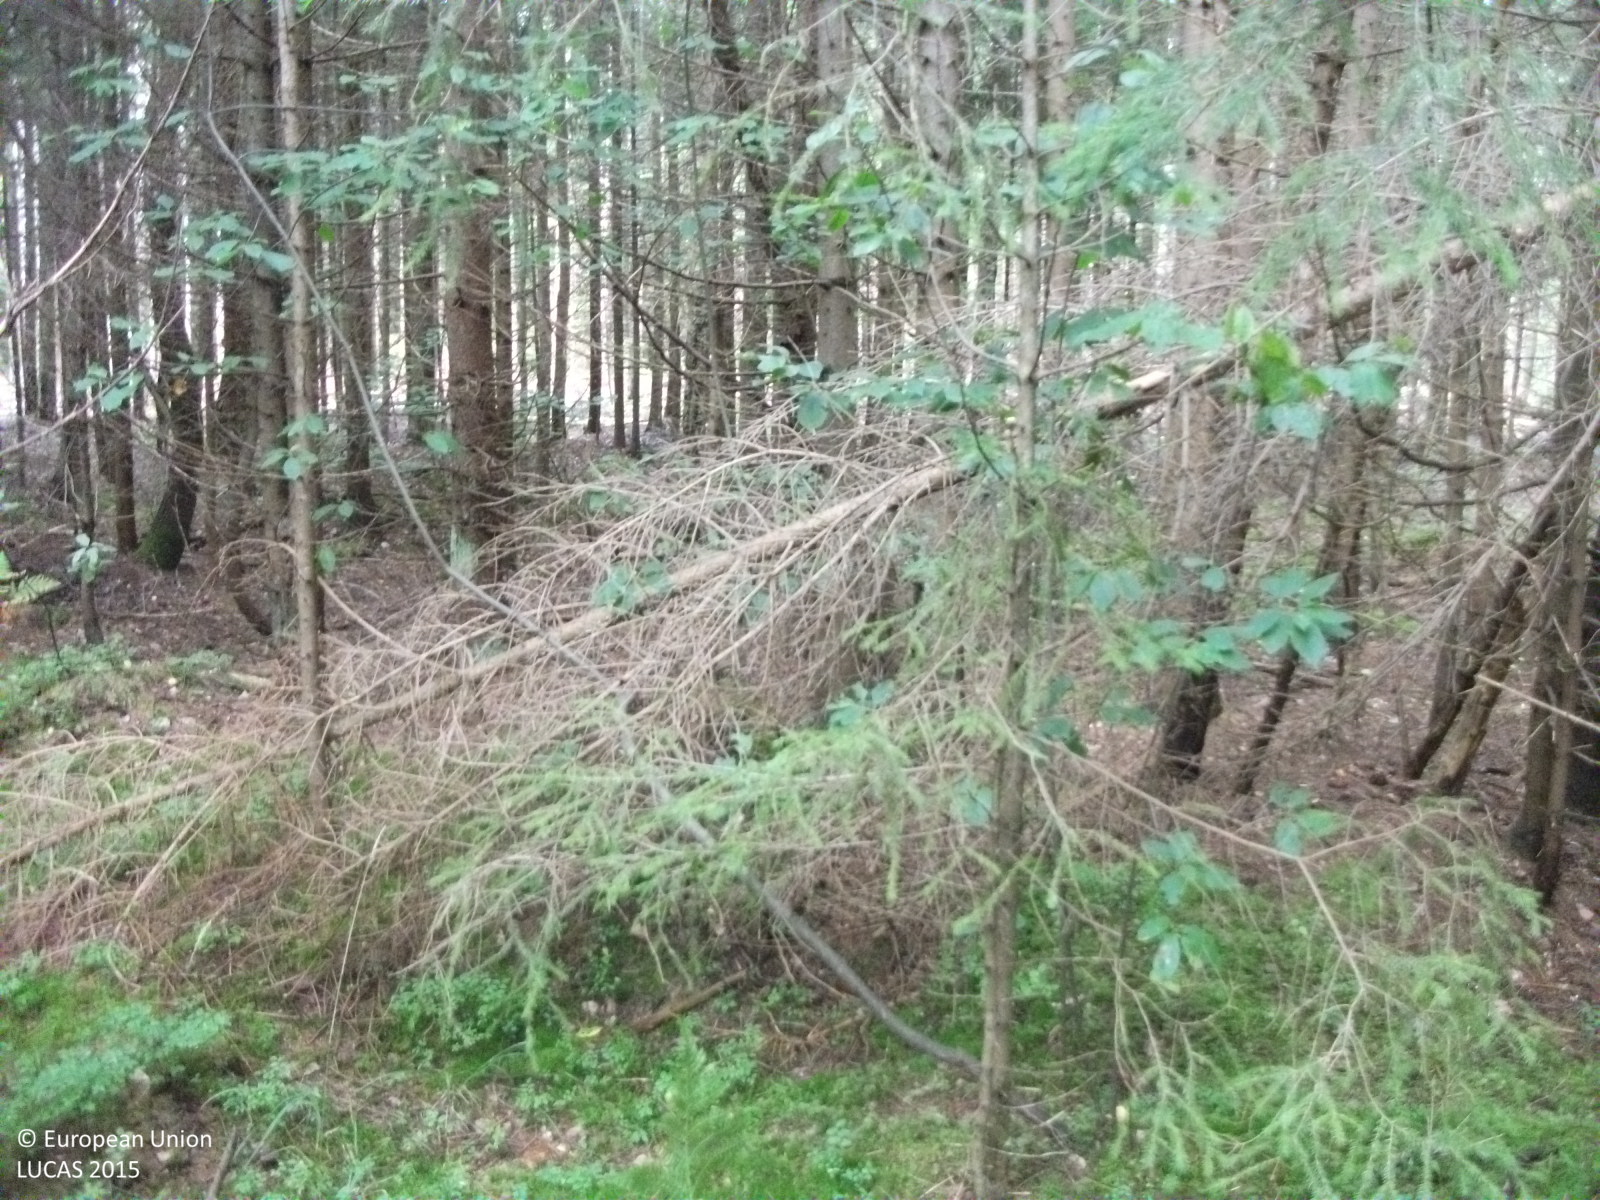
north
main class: Woodland
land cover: Spruce dominated coniferous woodland
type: hemiboreal forest and nemoral coniferous forest and mixed broadleaved-coniferous forest
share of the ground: > 75 %
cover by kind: coniferous forest trees 90 %, broadleaved forest trees 5 %, shrubs 5 %
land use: Forestry
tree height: > 5 m
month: September
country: LV
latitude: 57.6034
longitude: 24.3962
